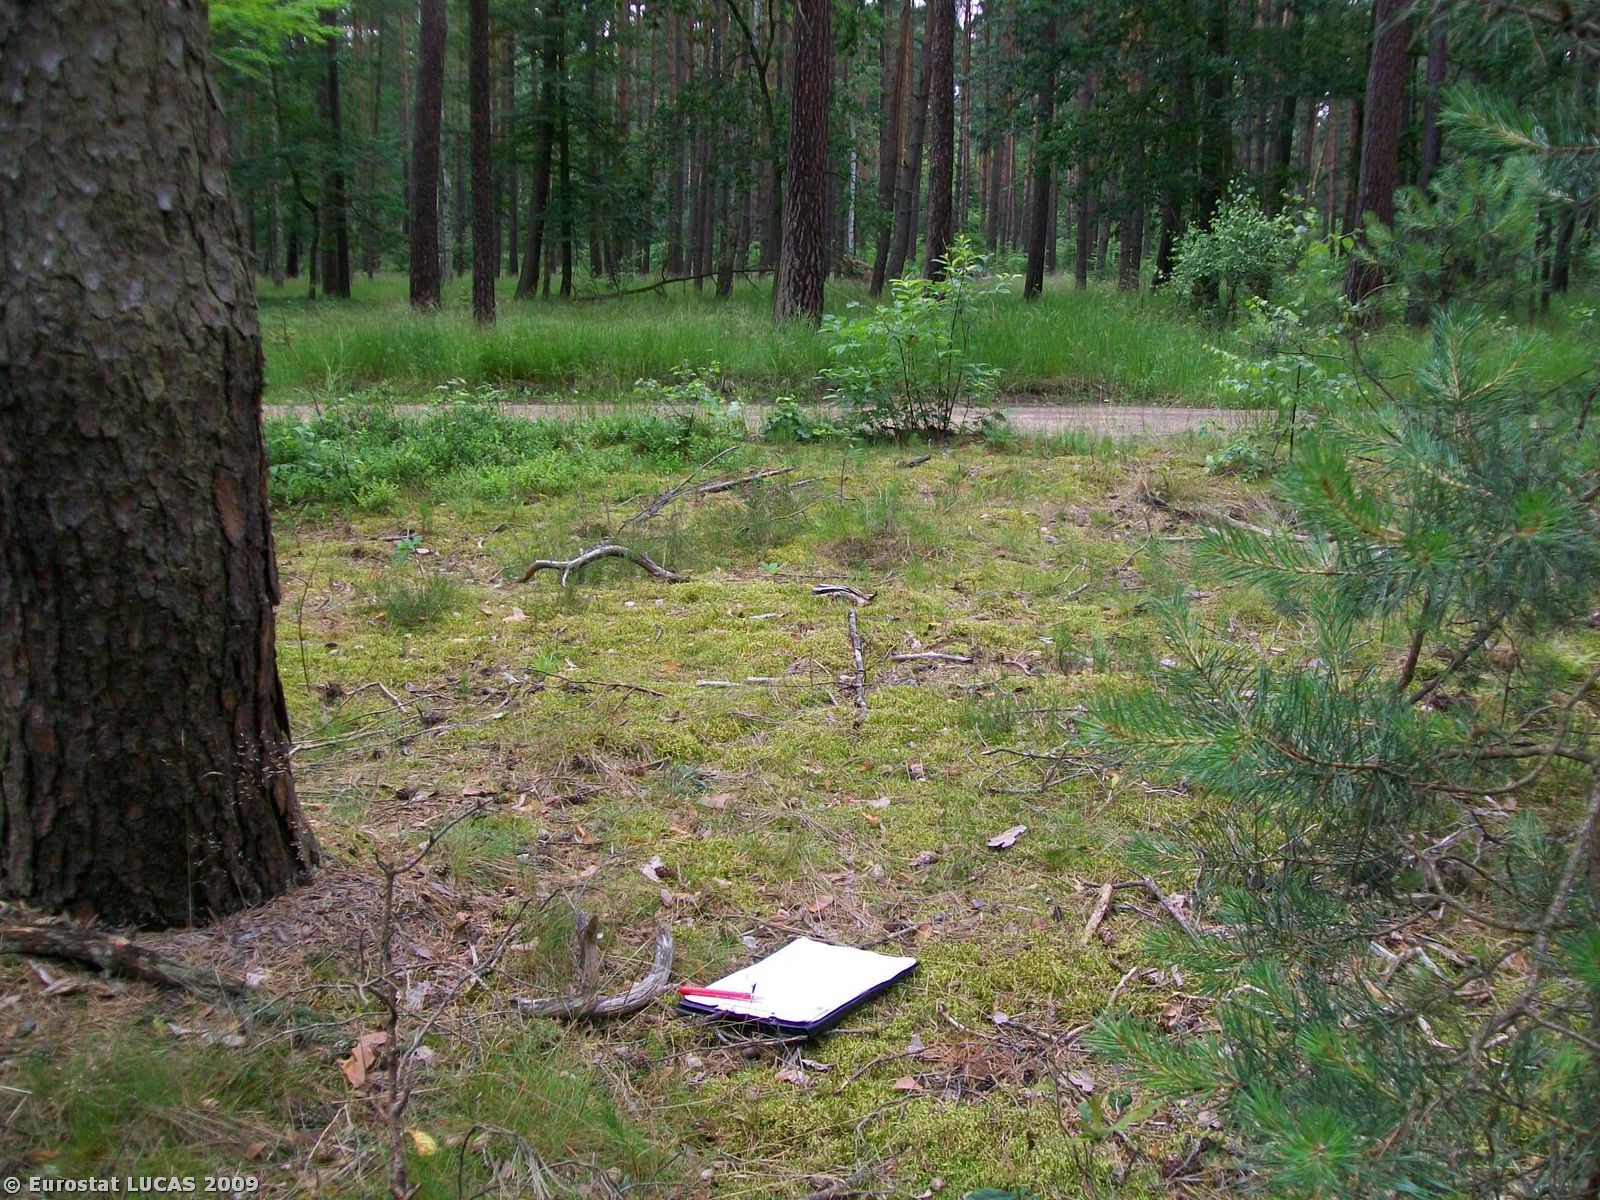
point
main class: Woodland
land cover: Mixed woodland
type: hemiboreal forest and nemoral coniferous forest and mixed broadleaved-coniferous forest
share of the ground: > 75 %
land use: Forestry
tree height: > 5 m
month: June
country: PL
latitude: 51.4530
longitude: 15.1984
